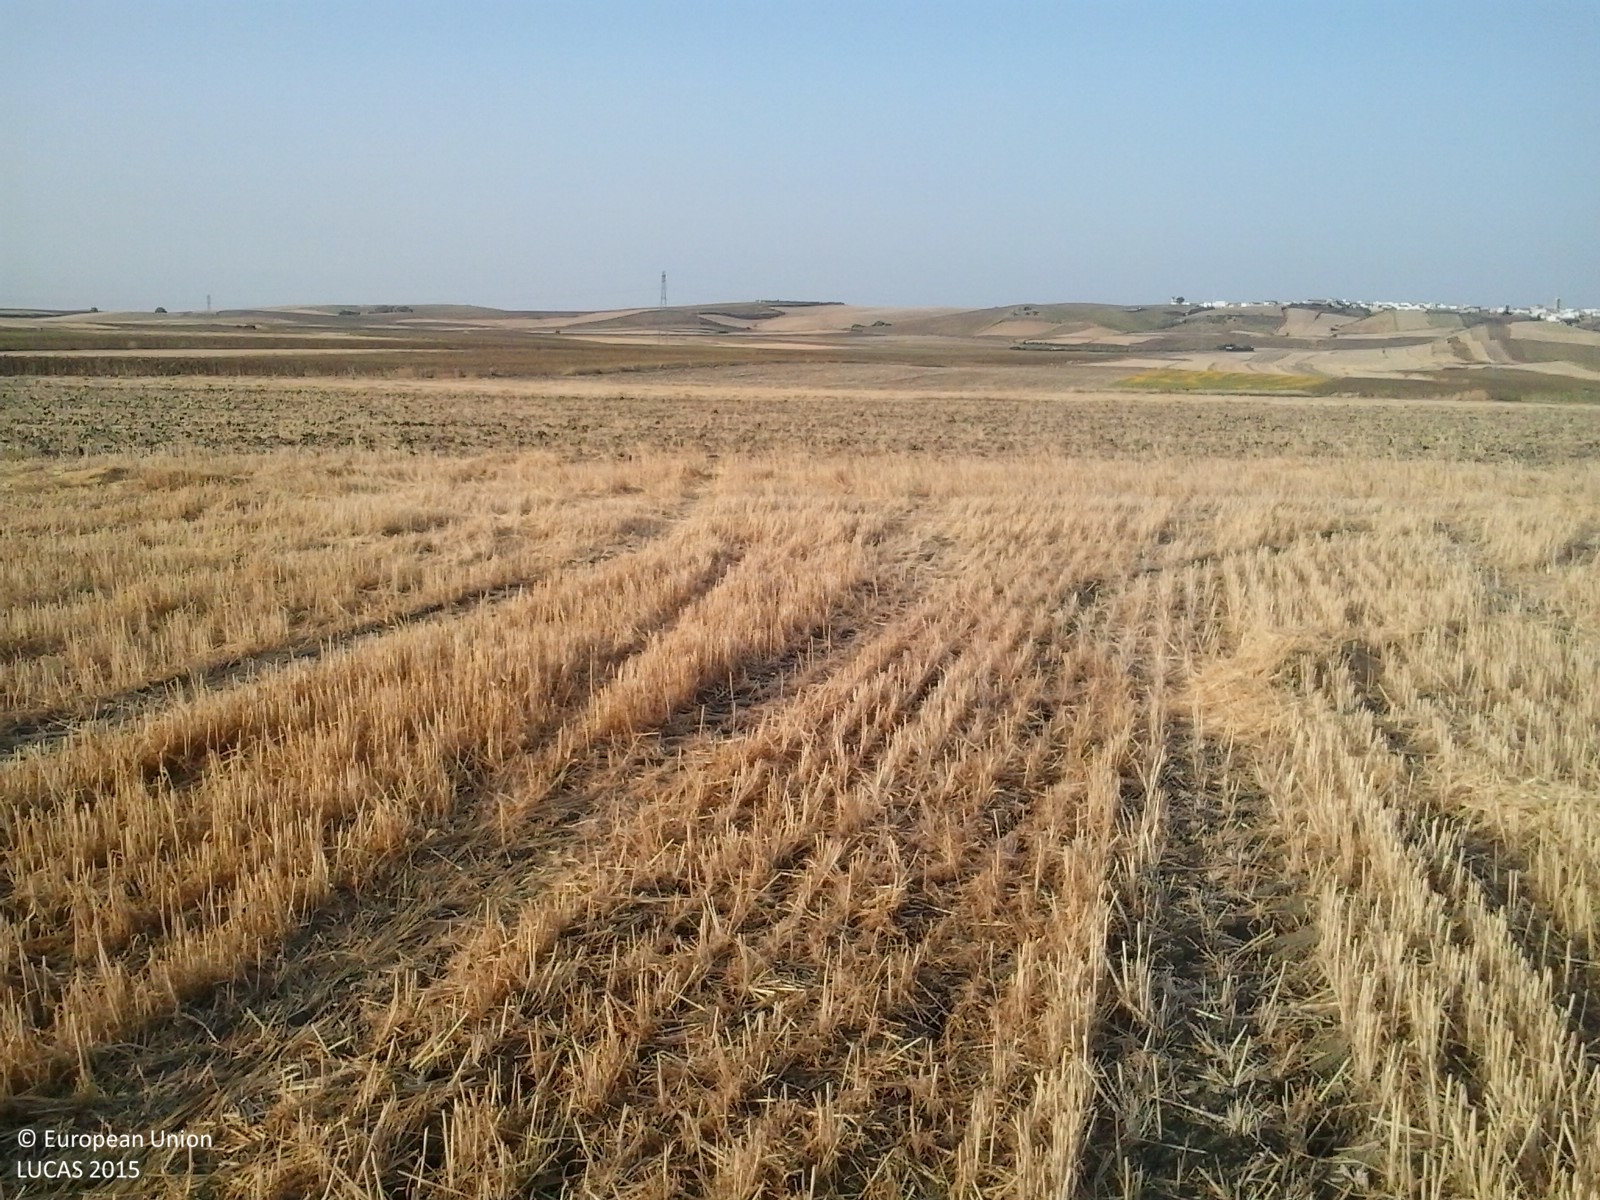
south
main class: Cropland
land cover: Common wheat
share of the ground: < 10 %
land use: Agriculture (excluding fallow land and kitchen gardens)
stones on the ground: < 10 %
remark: Harvested field
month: July
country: ES
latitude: 37.4412
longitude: -6.3864
